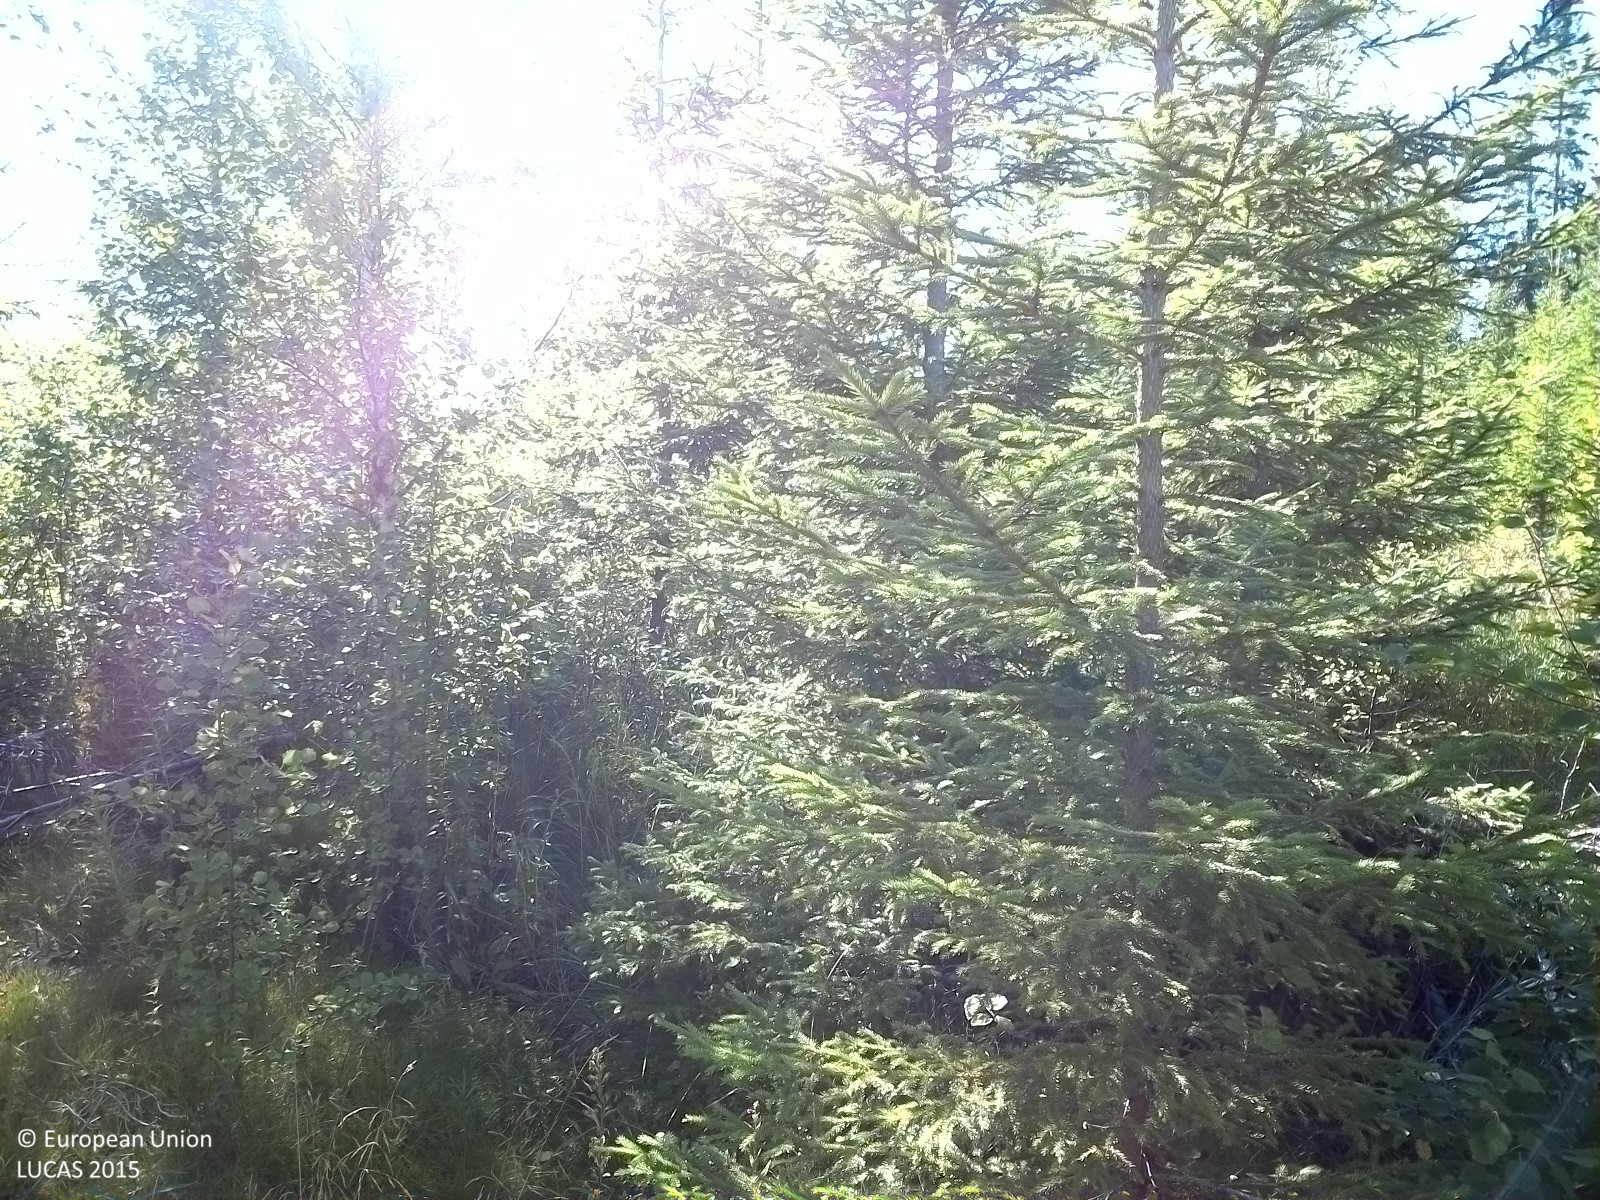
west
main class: Woodland
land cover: Spruce dominated mixed woodland
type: boreal forest
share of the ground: 50 - 75 %
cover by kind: herbaceous plants 50 %, coniferous forest trees 35 %, broadleaved forest trees 15 %
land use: Forestry
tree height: < 5 m
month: August
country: SE
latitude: 62.2953
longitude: 16.4006
